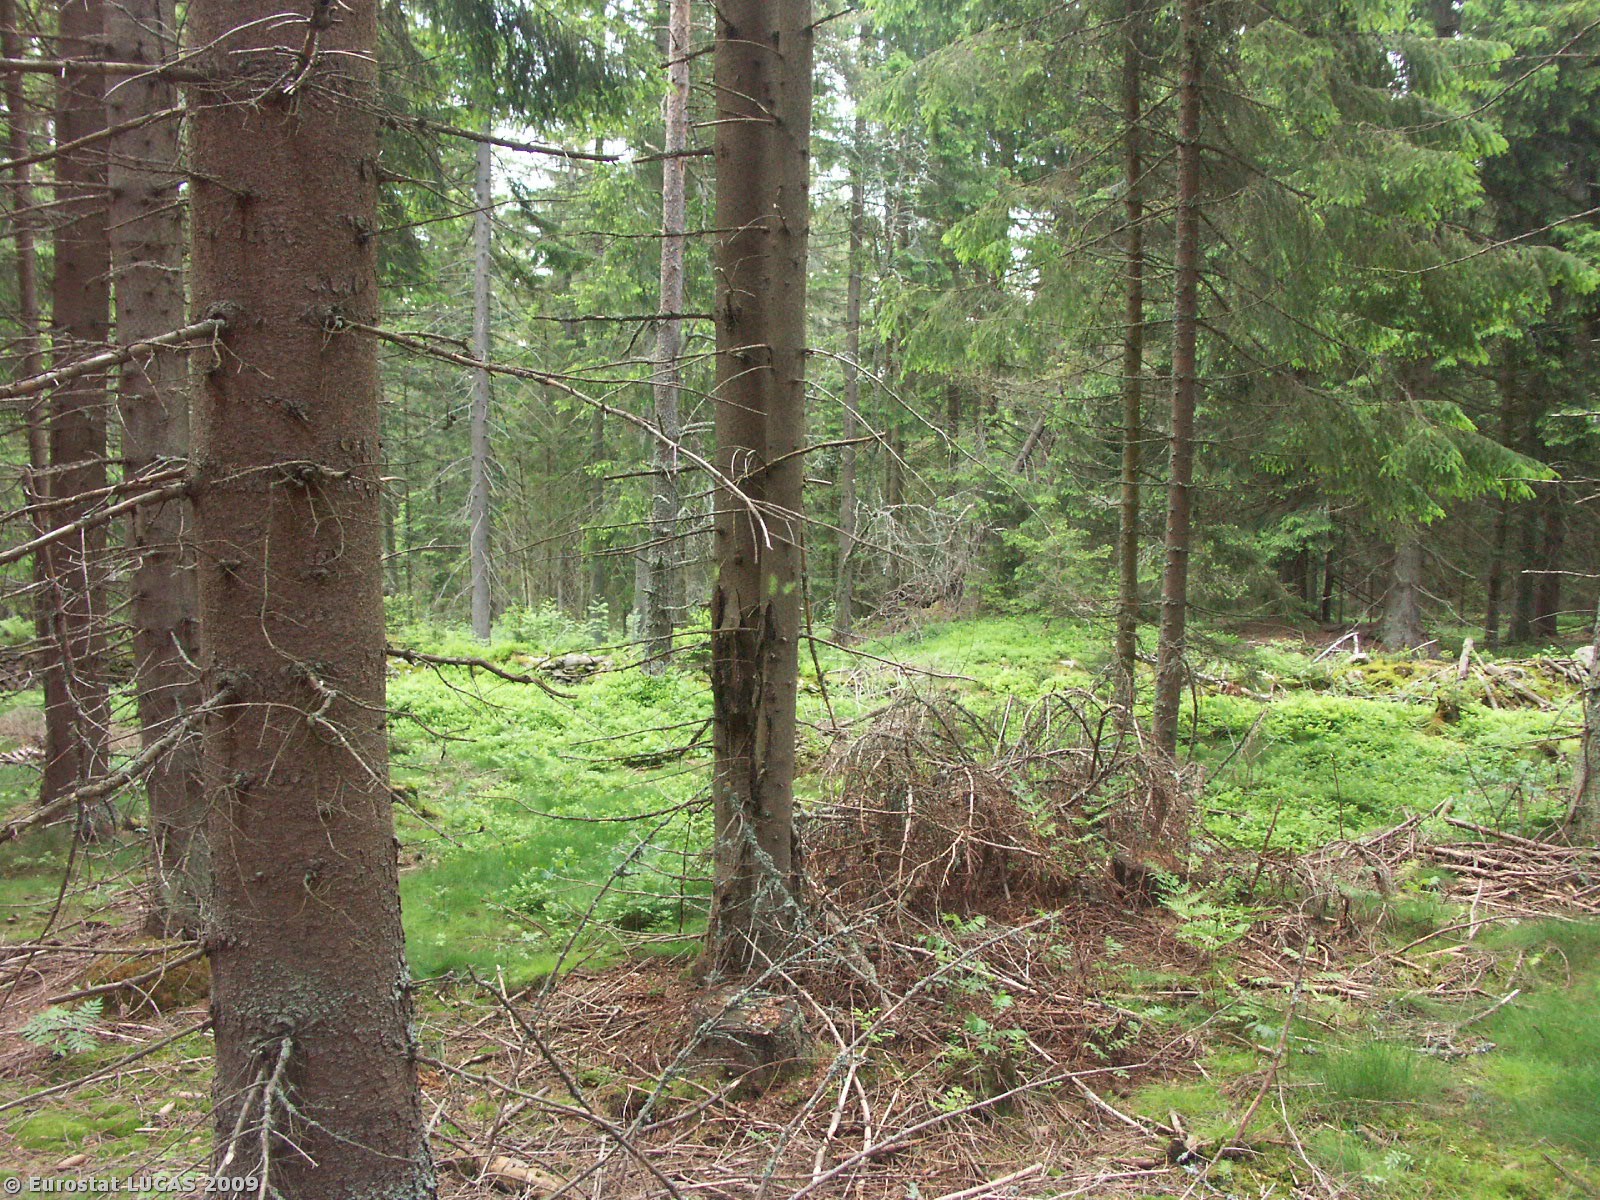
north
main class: Woodland
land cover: Coniferous woodland
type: hemiboreal forest and nemoral coniferous forest and mixed broadleaved-coniferous forest
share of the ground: > 75 %
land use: Forestry
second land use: Nature reserves
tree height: > 5 m
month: May
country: CZ
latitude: 48.9096
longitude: 13.9434
